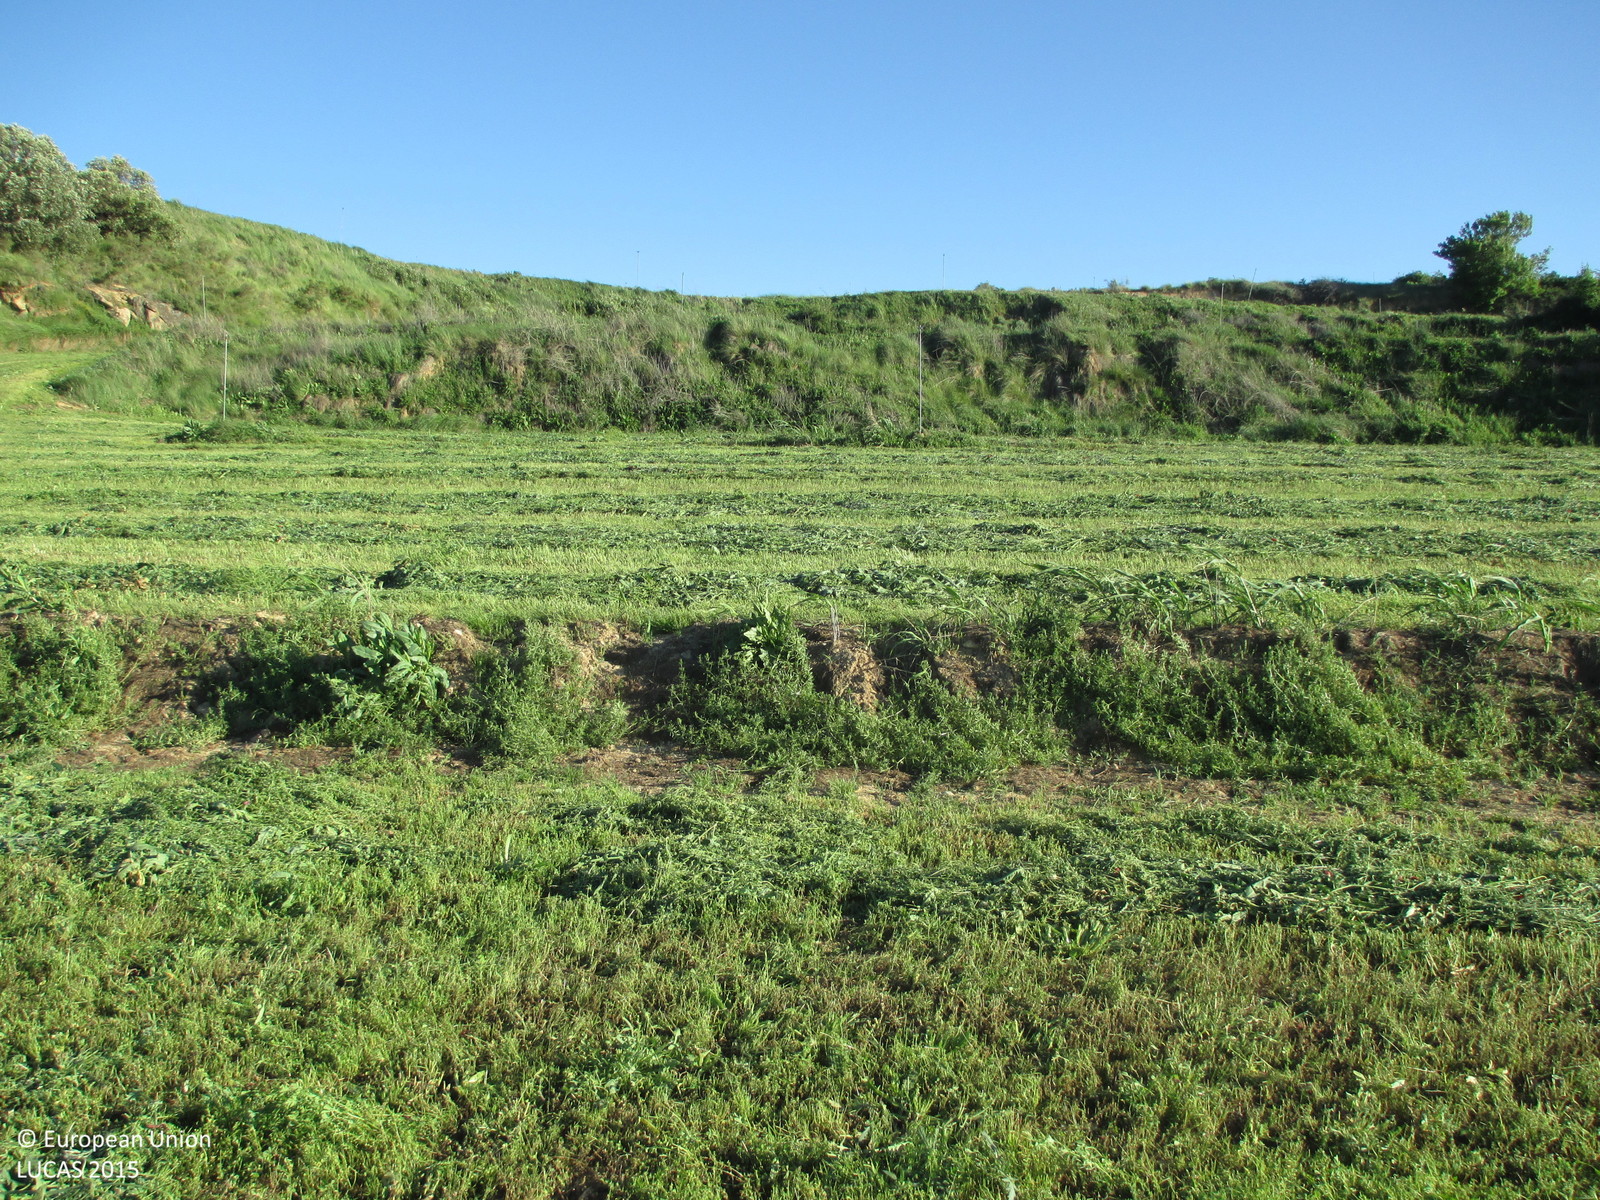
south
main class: Cropland
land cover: Lucerne
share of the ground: > 75 %
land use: Agriculture (excluding fallow land and kitchen gardens)
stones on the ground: < 10 %
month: May
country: ES
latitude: 42.0120
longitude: -0.0049
